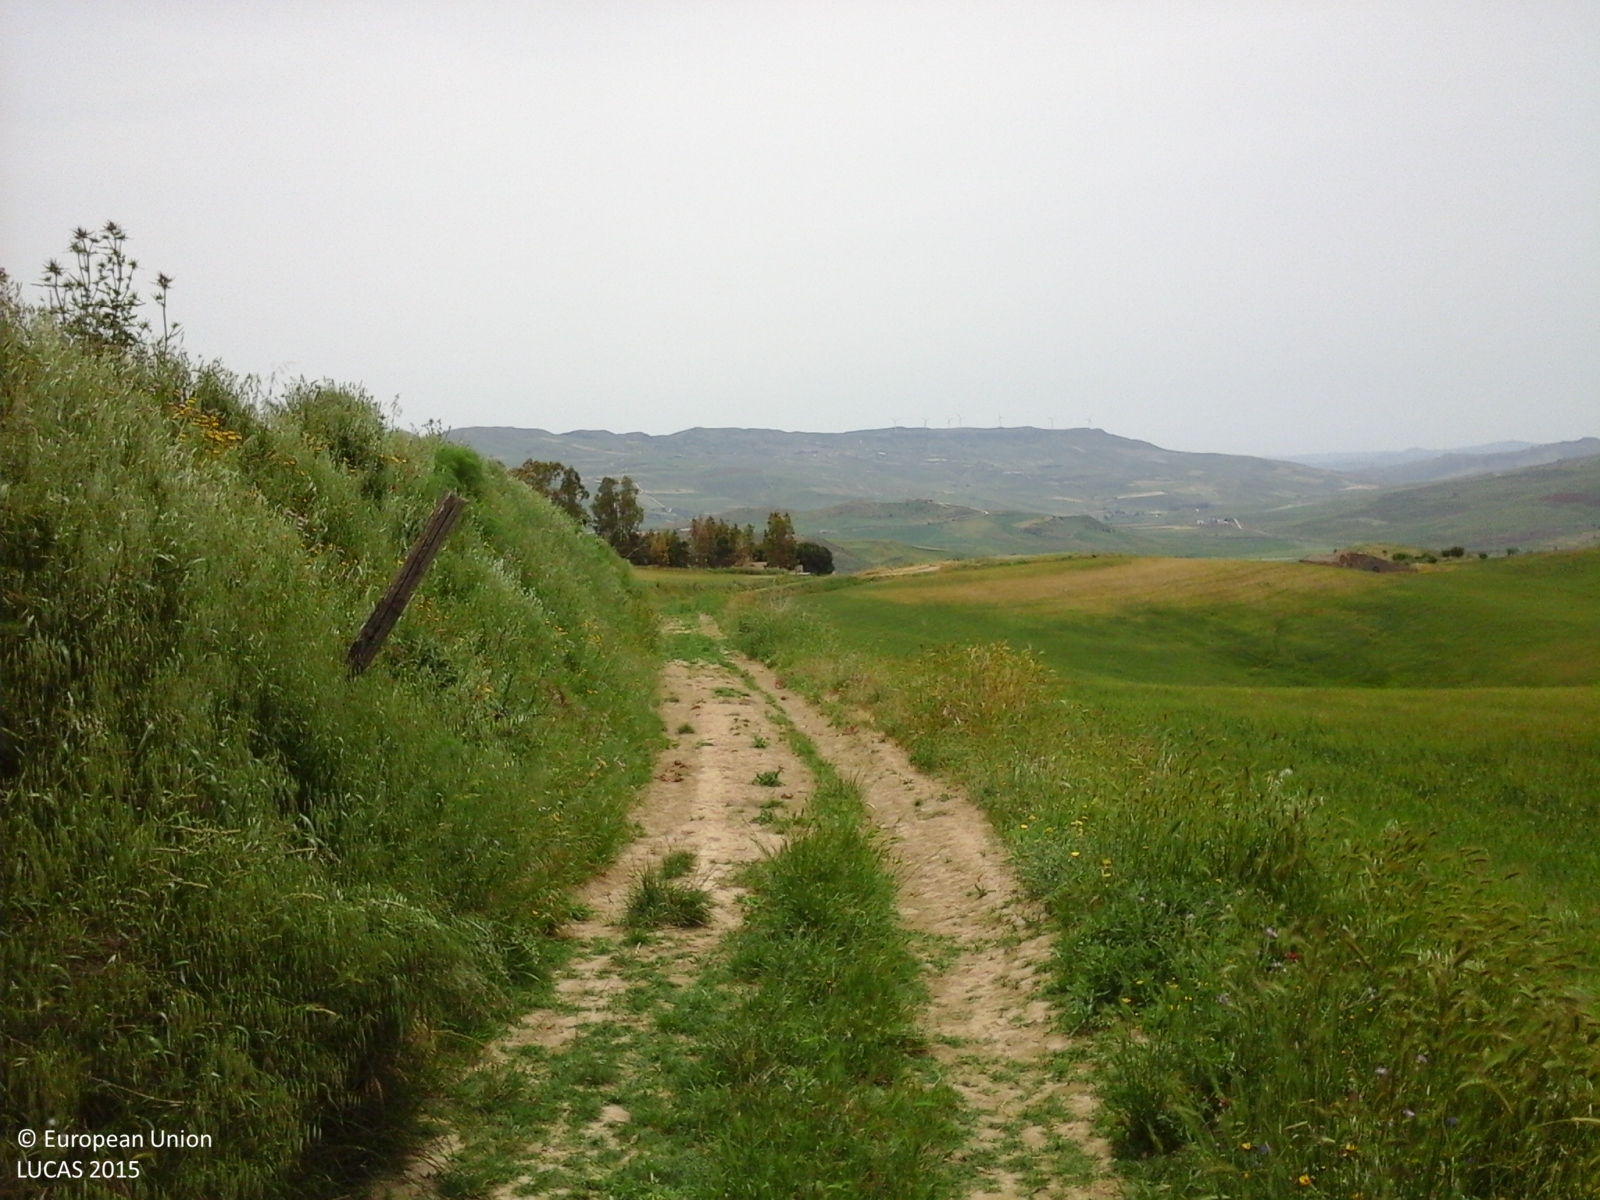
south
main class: Cropland
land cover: Arable land (only in case pi)
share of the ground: > 75 %
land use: Agriculture (excluding fallow land and kitchen gardens)
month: May
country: IT
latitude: 37.6855
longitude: 13.9063
